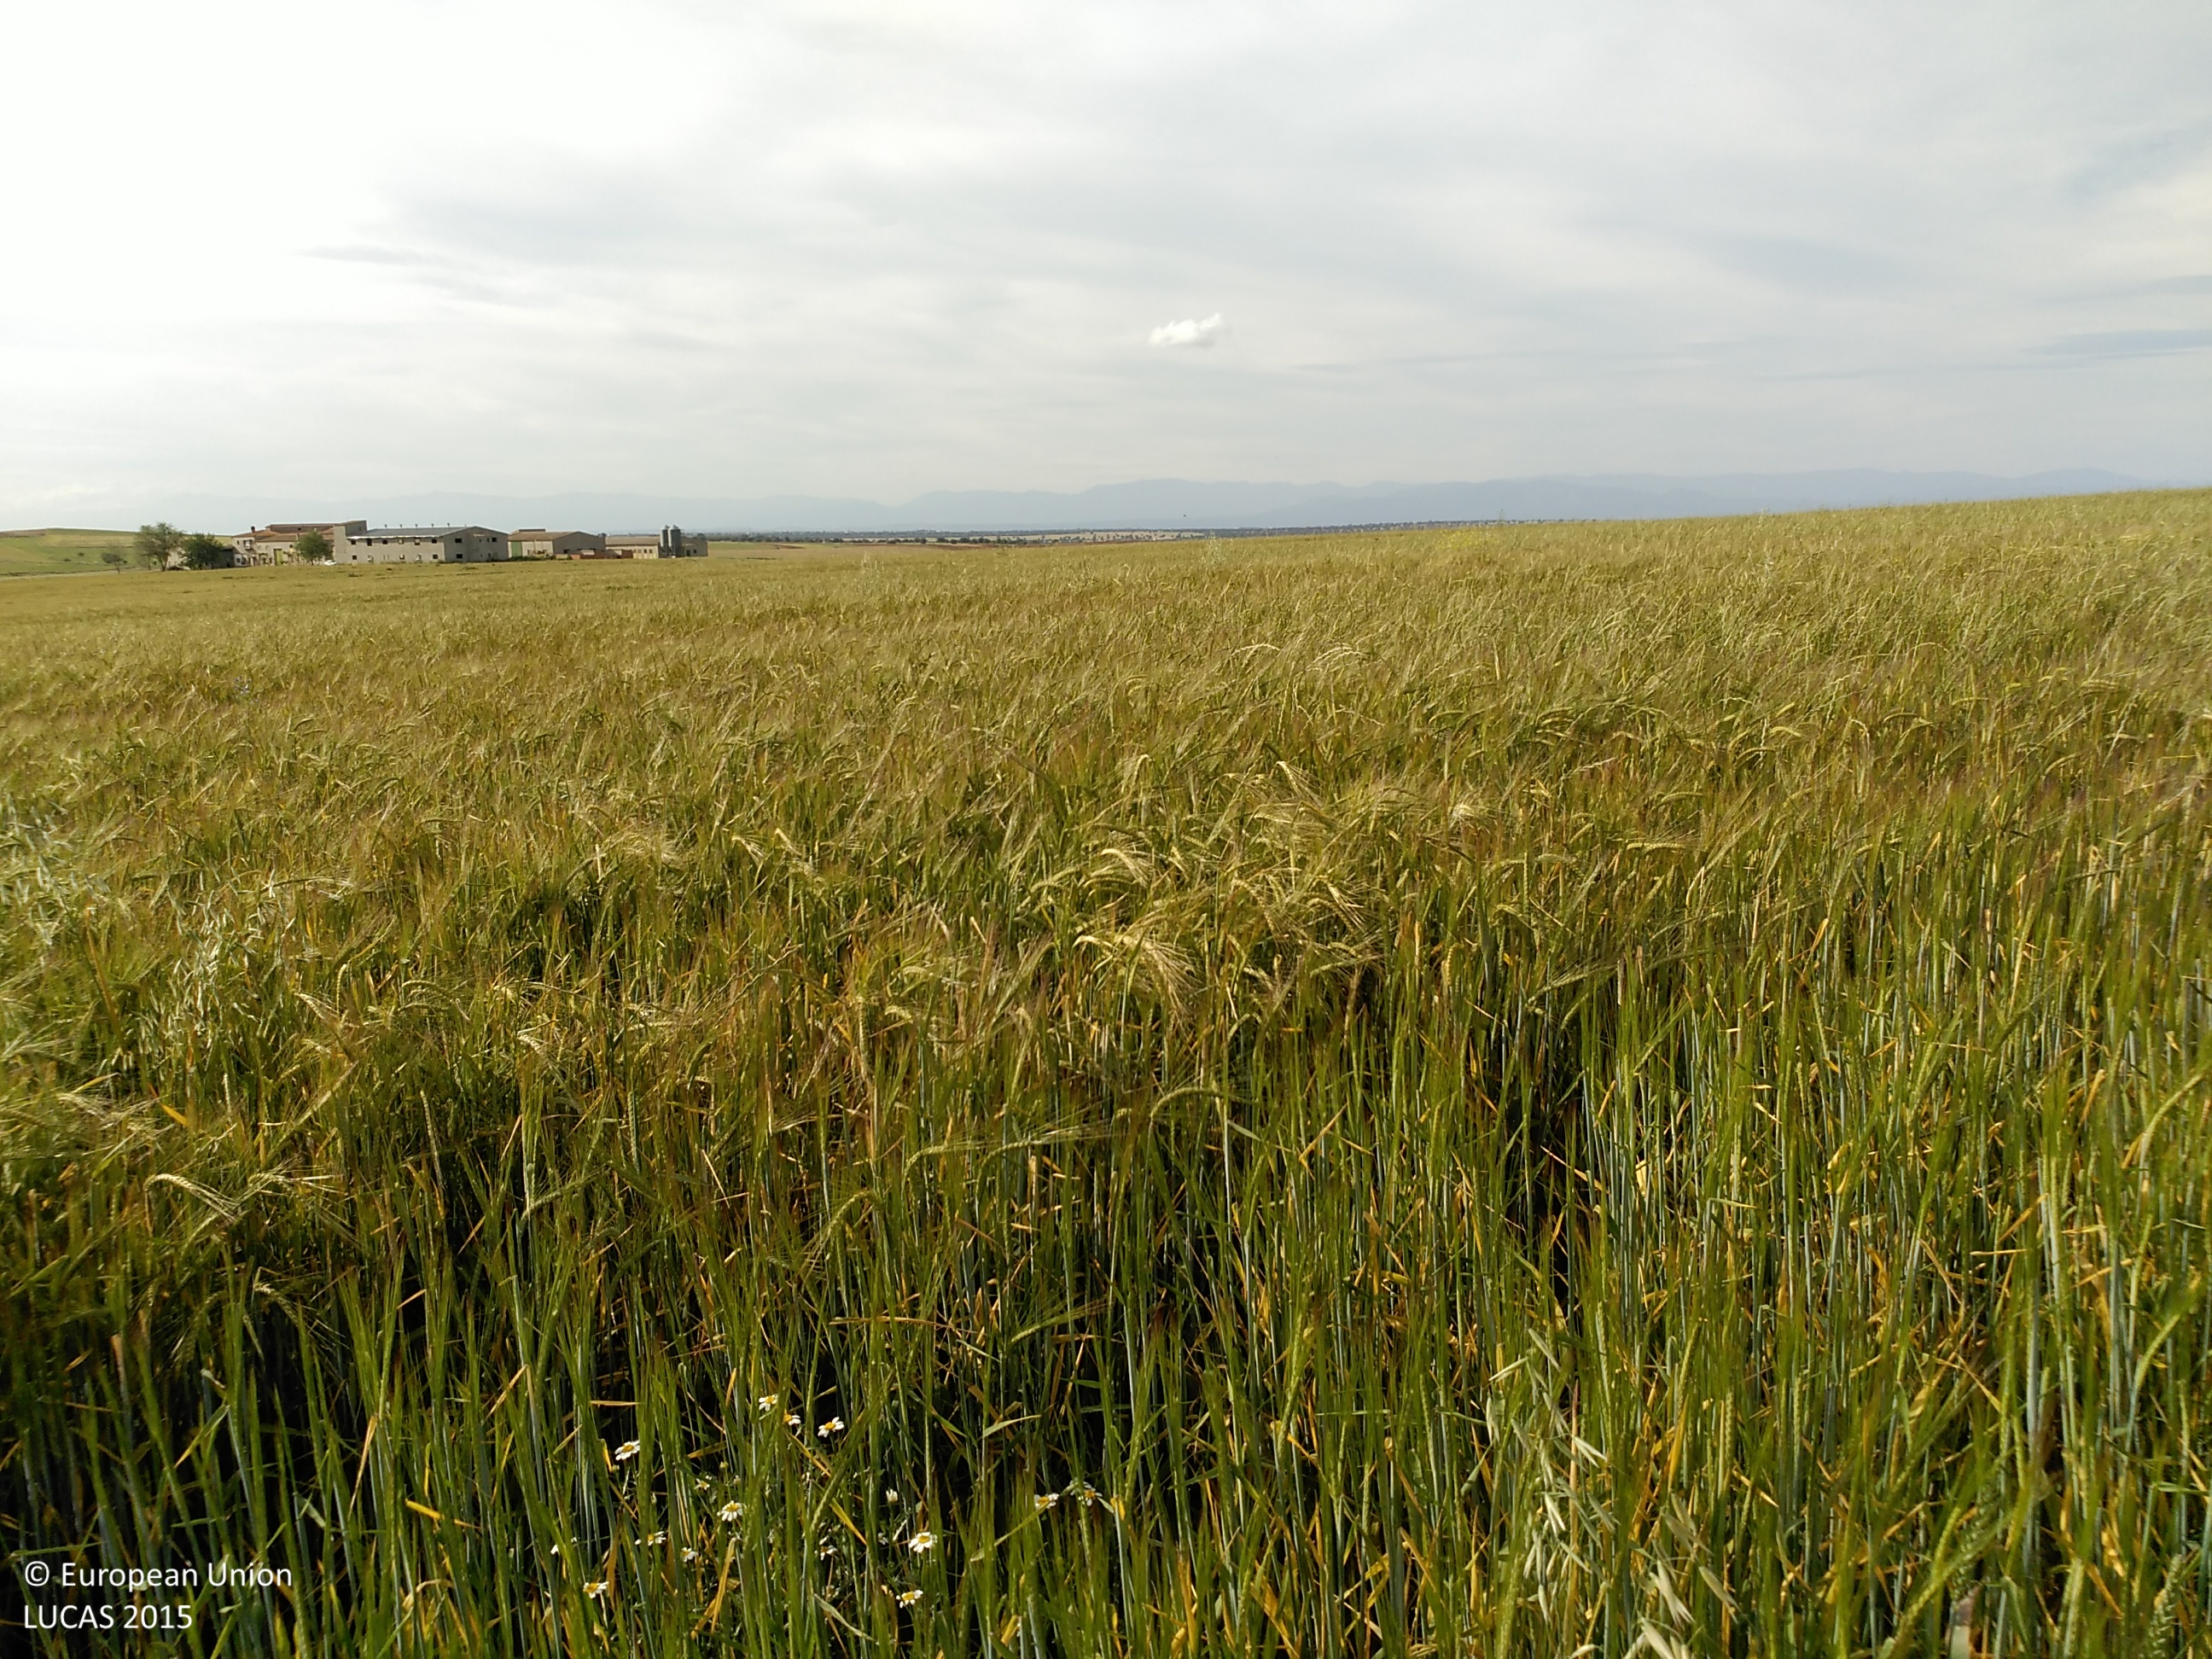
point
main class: Cropland
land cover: Barley
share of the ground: > 75 %
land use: Agriculture (excluding fallow land and kitchen gardens)
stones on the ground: < 10 %
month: May
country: ES
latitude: 39.7638
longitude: -4.6688
